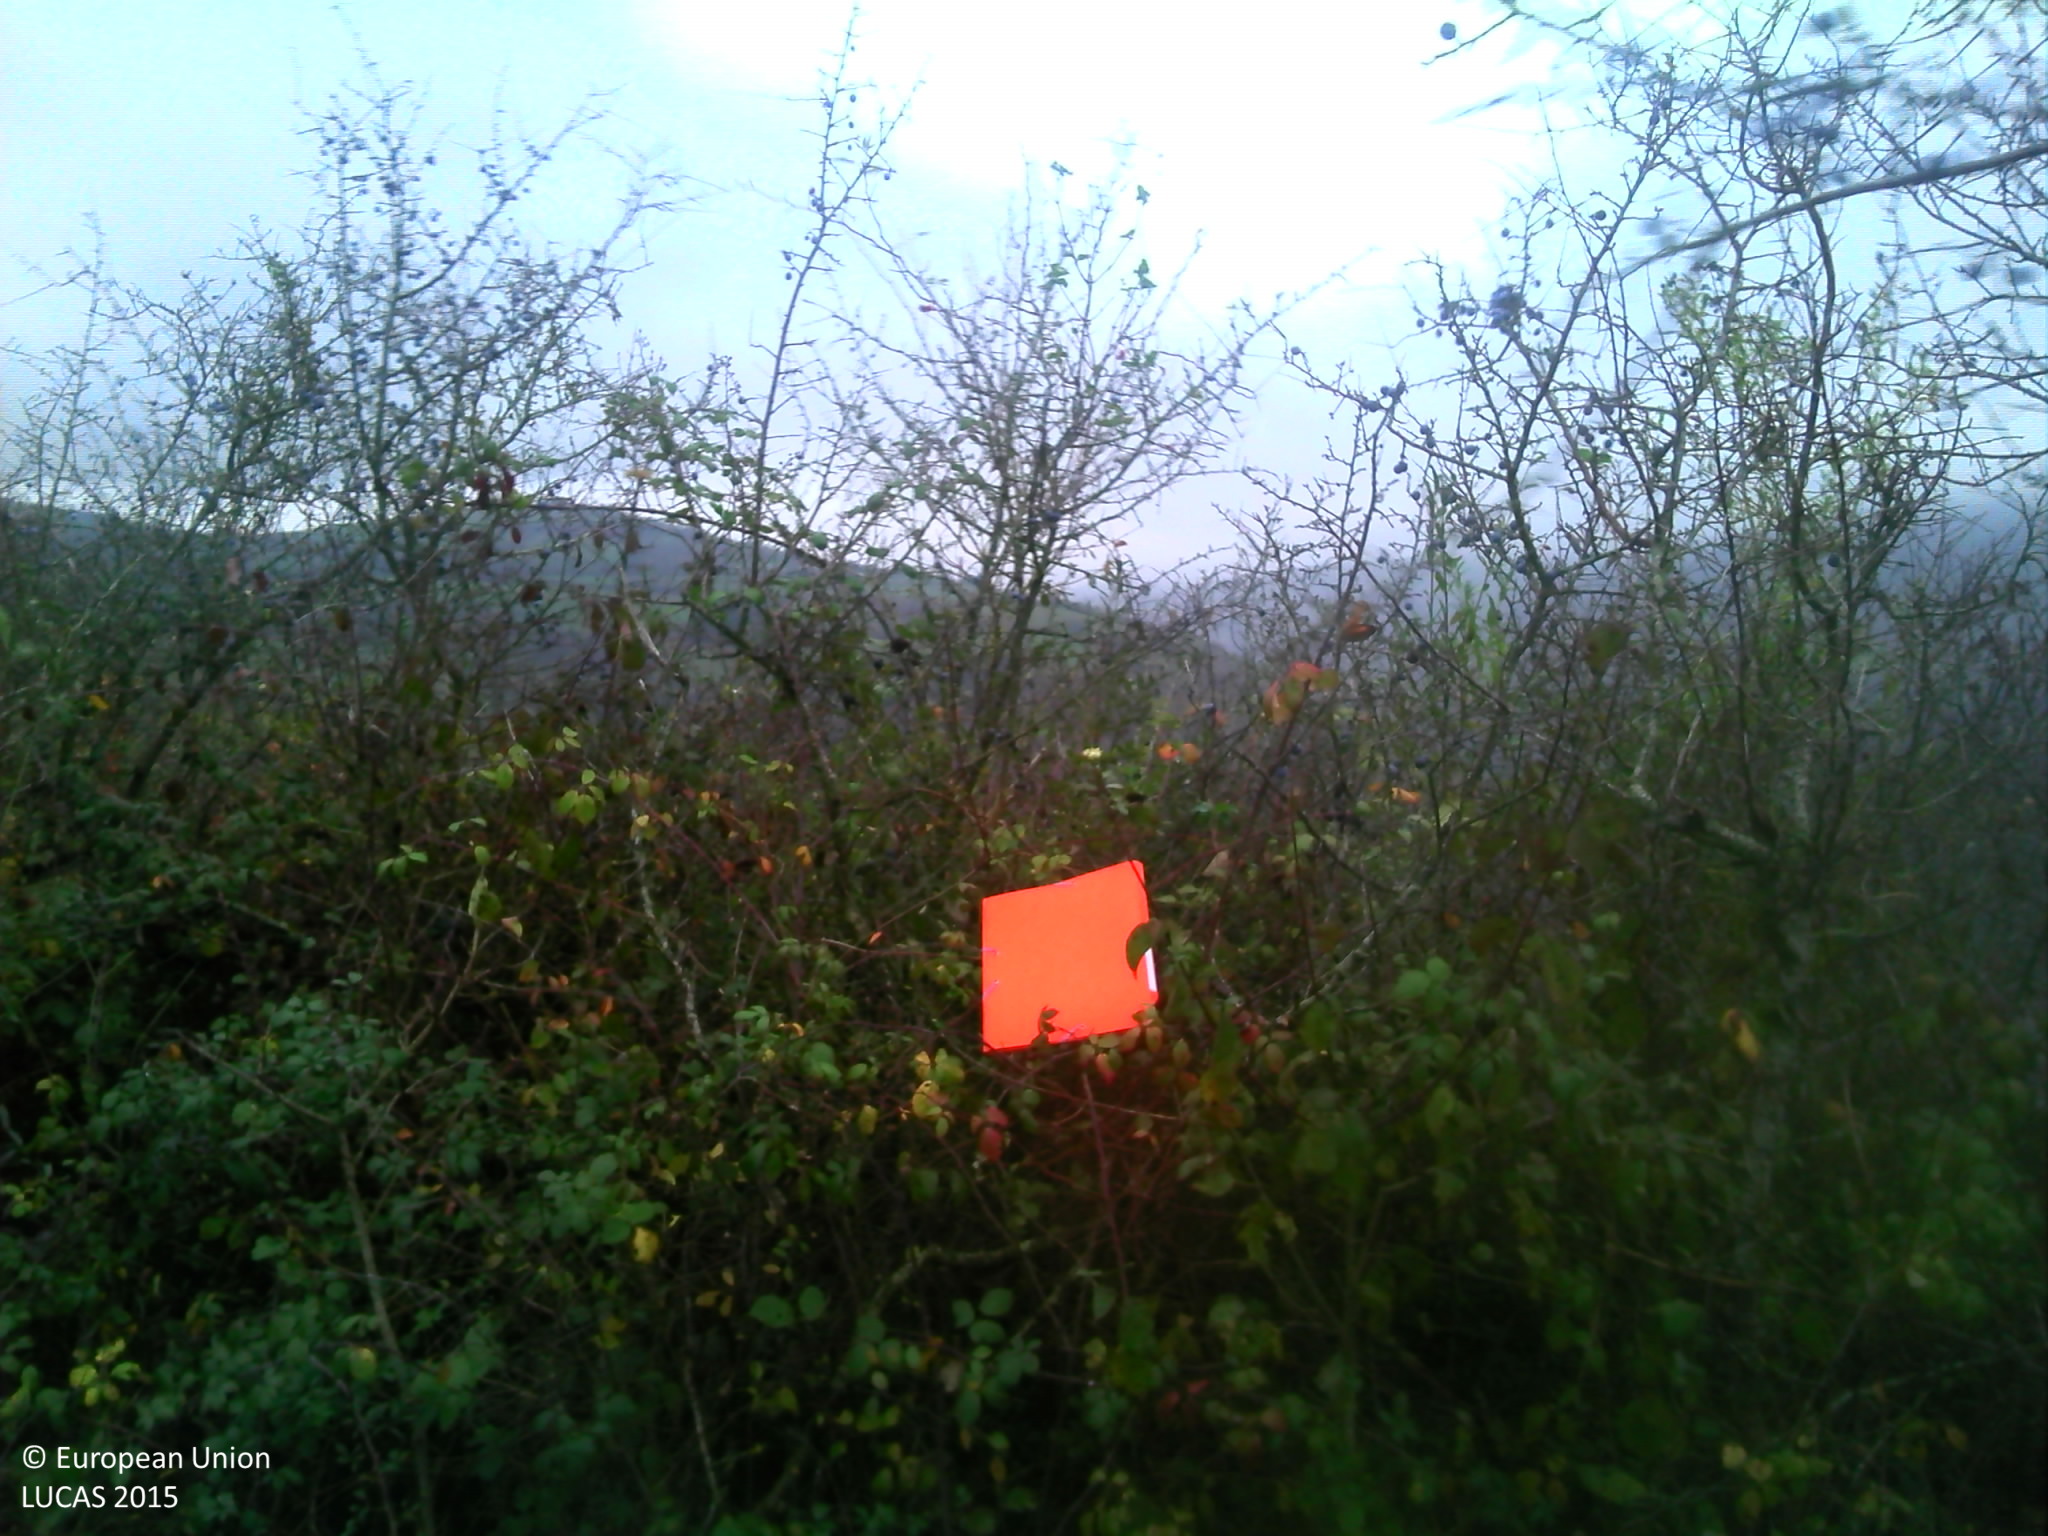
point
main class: Shrubland
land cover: Shrubland with sparse tree cover
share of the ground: > 75 %
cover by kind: shrubs 95 %, broadleaved forest trees 5 %
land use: Agriculture (excluding fallow land and kitchen gardens)
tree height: < 5 m
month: November
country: FR
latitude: 44.0143
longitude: 2.6080
